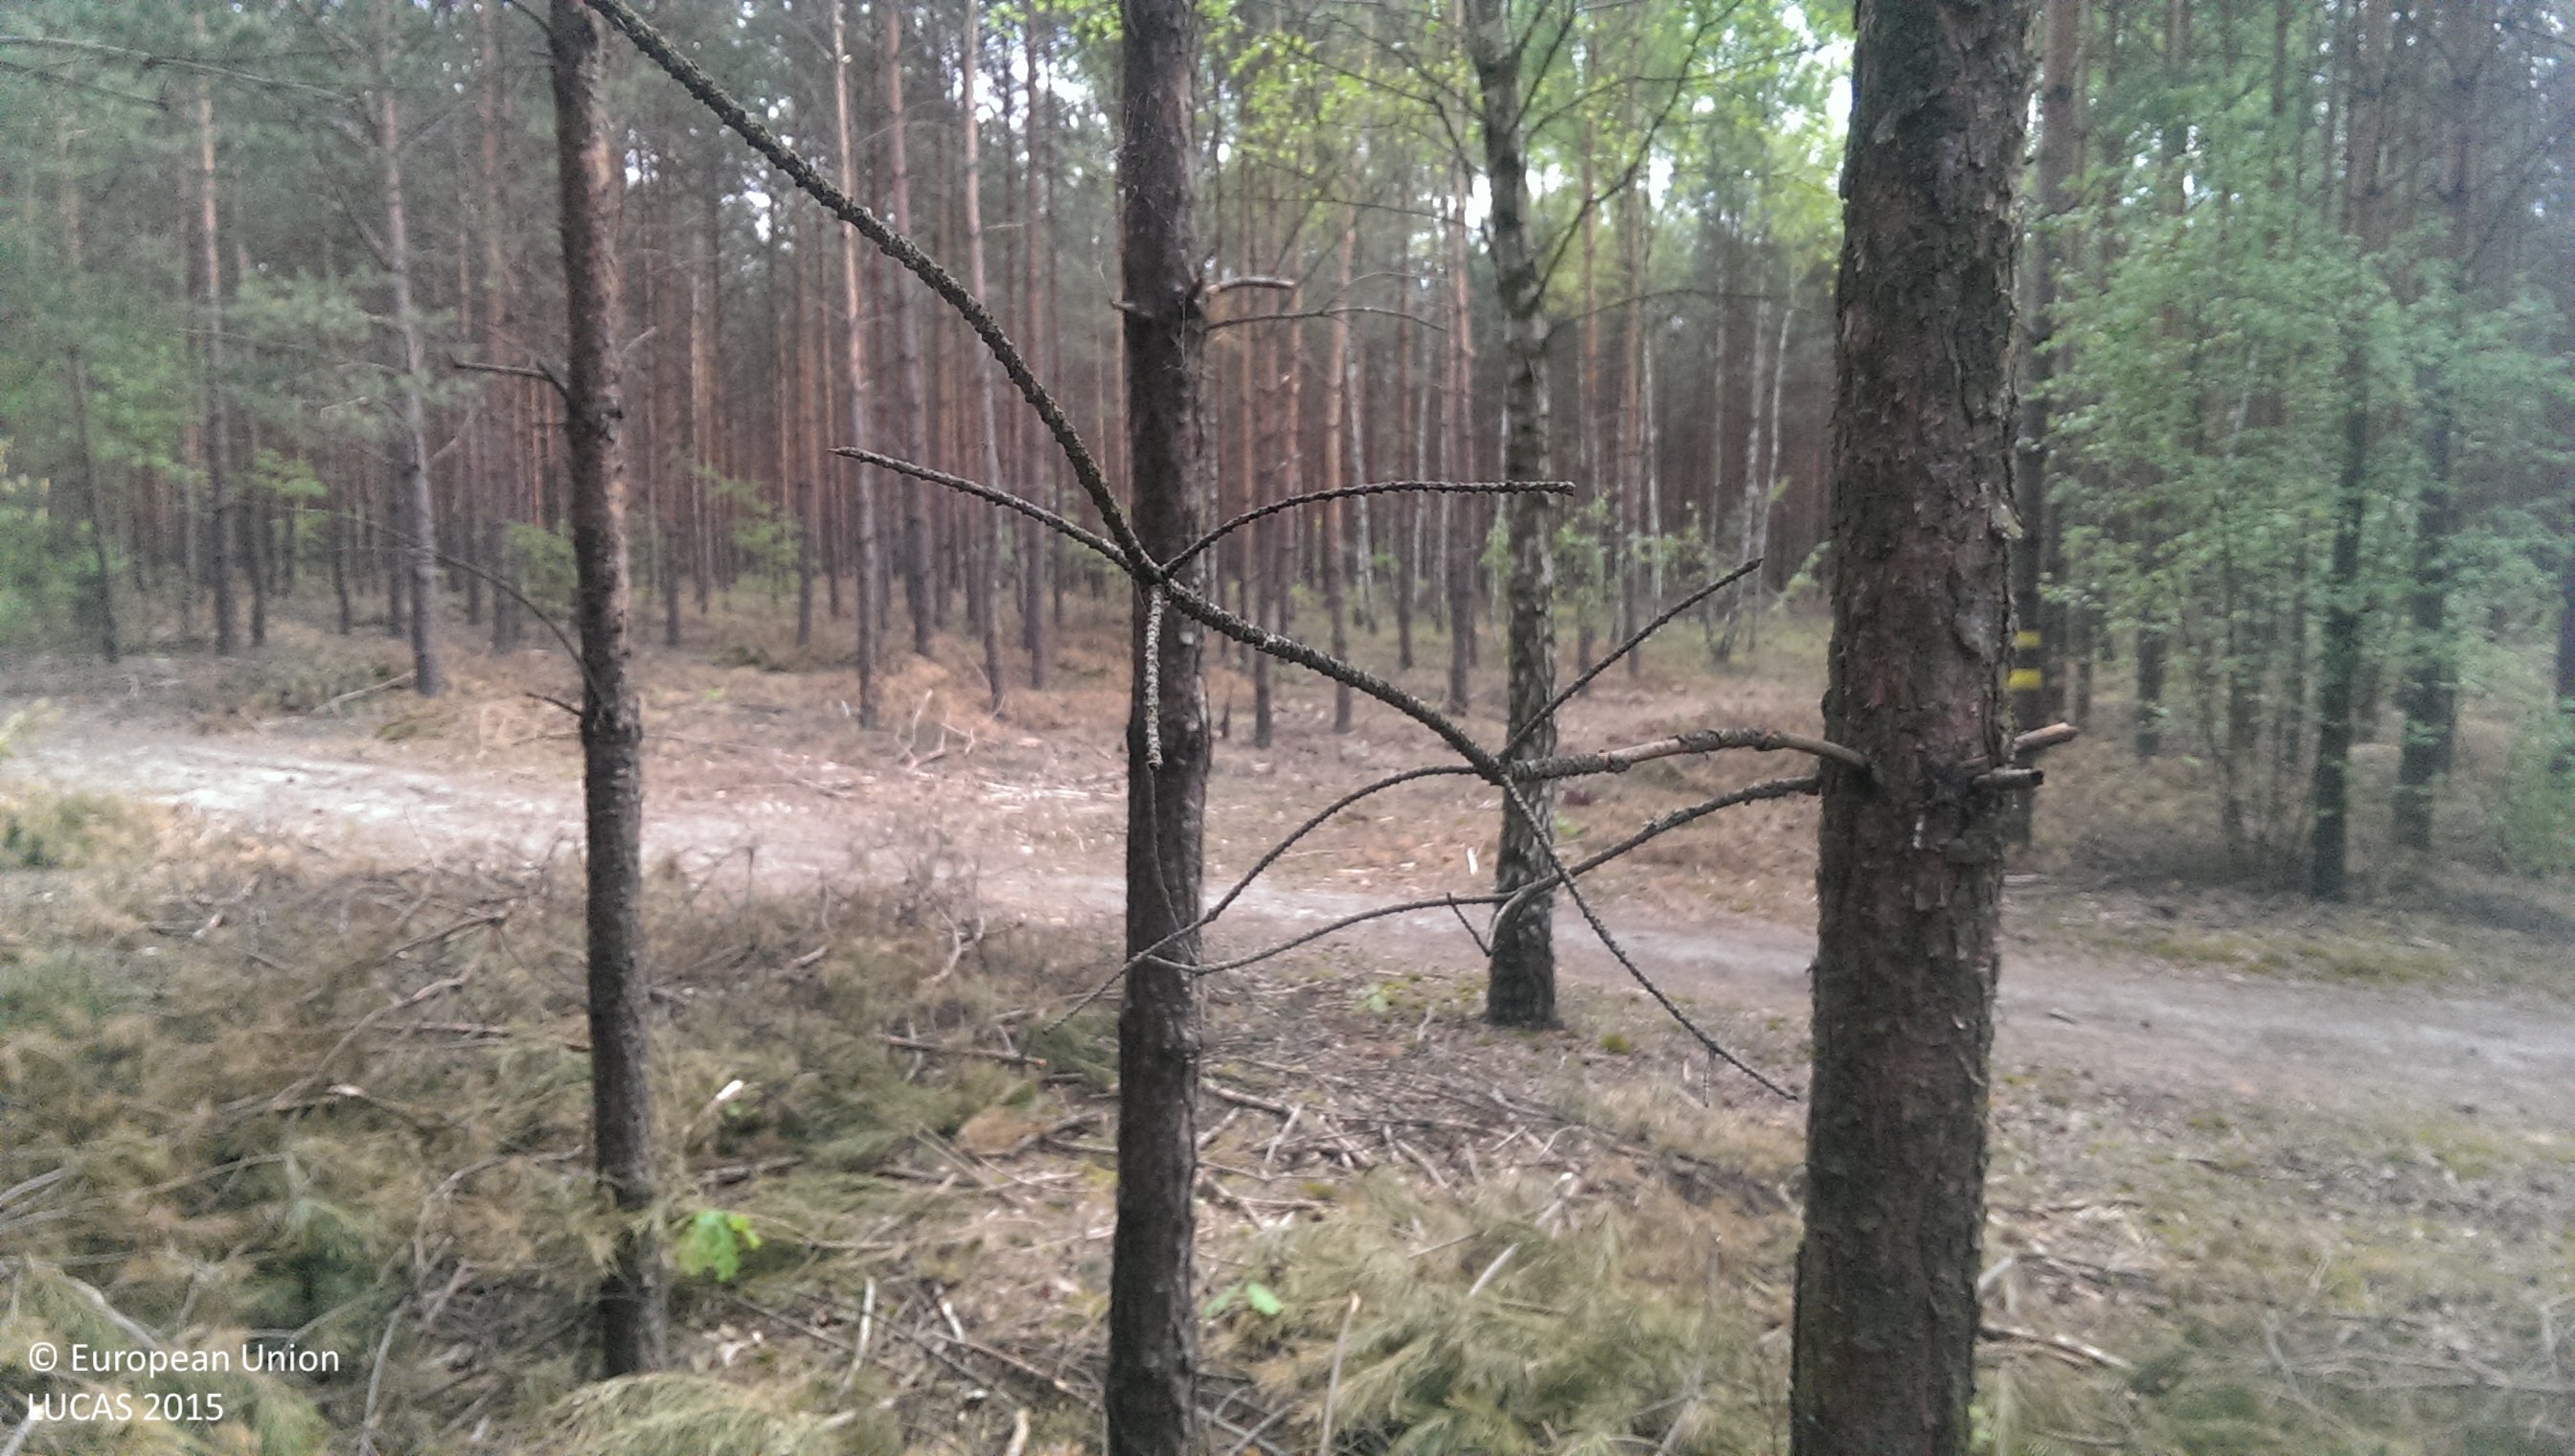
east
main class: Woodland
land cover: Pine dominated coniferous woodland
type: hemiboreal forest and nemoral coniferous forest and mixed broadleaved-coniferous forest
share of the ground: 50 - 75 %
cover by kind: coniferous forest trees 55 %, lichens and mosses 40 %, broadleaved forest trees 5 %
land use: Forestry
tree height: > 5 m
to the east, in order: Pine dominated coniferous woodland; Tracks; Pine dominated coniferous woodland; Grass margins; Paved roads, cycling and walking lanes; Grass margins; Pine dominated coniferous woodland
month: May
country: PL
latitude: 52.3230
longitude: 16.2126
